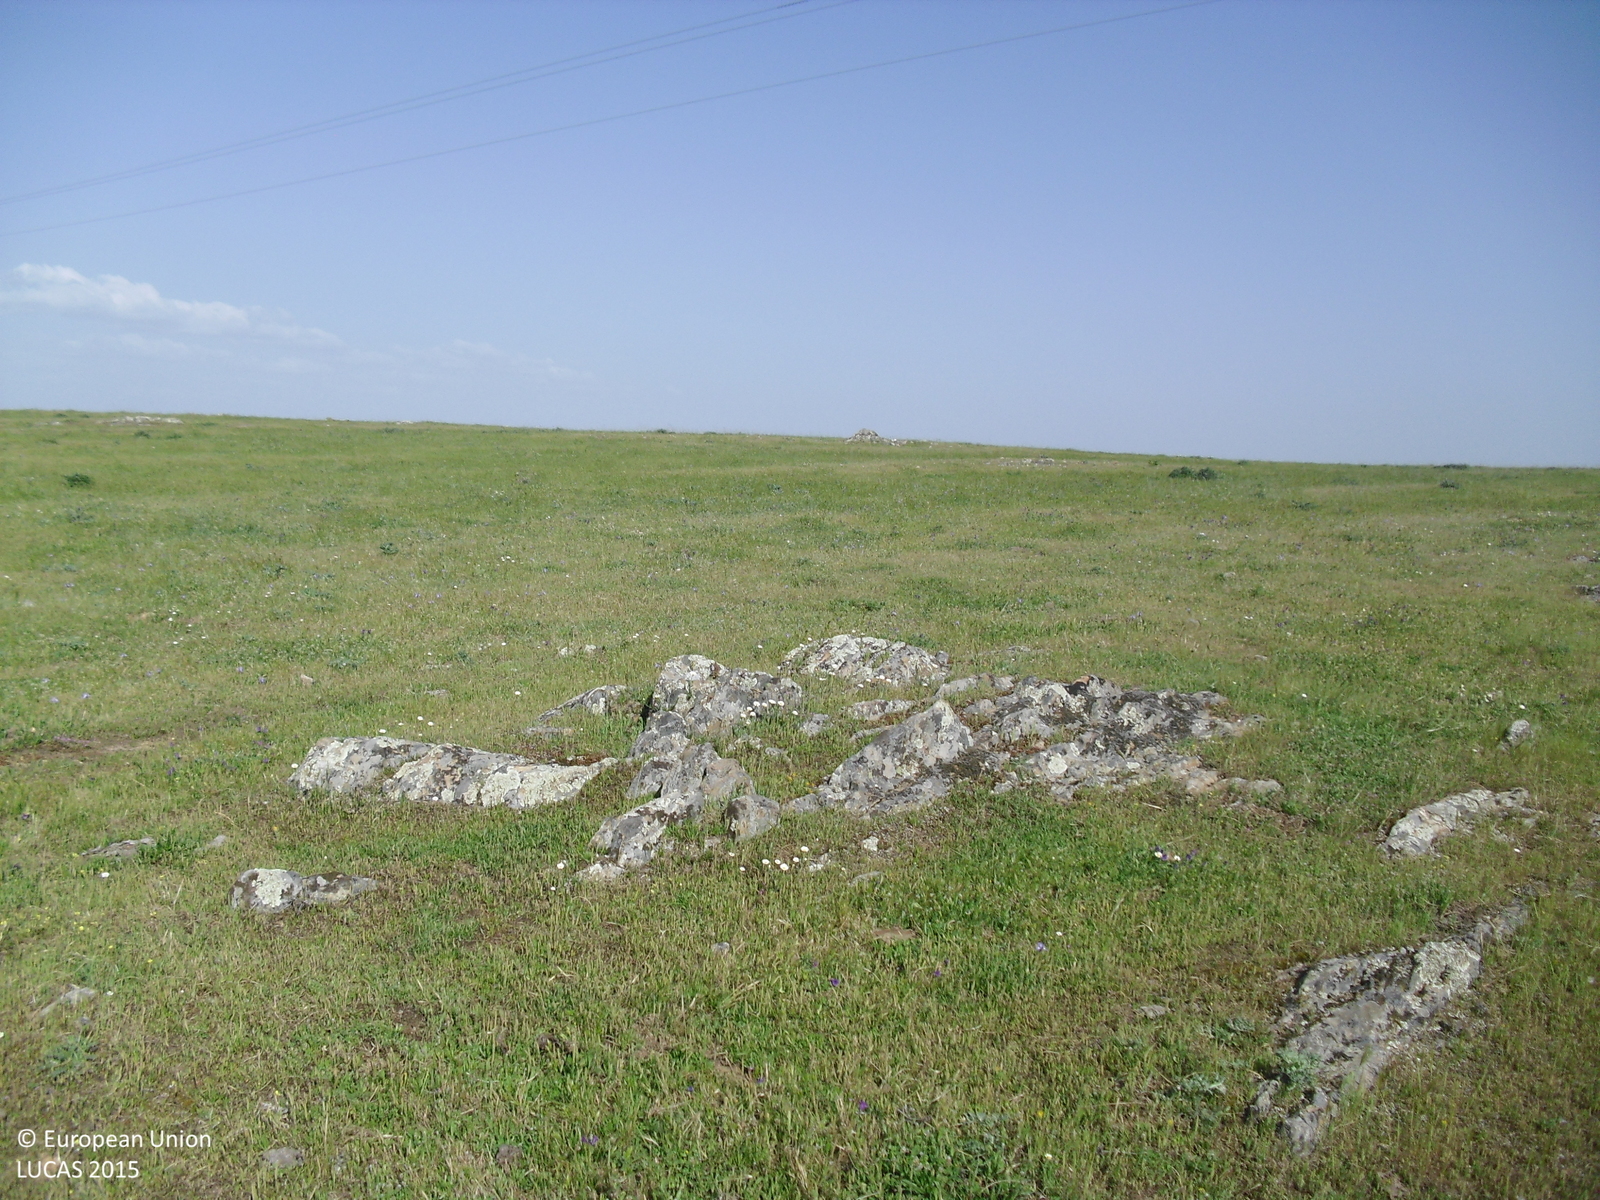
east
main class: Grassland
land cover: Grassland without tree/shrub cover
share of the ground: > 75 %
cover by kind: herbaceous plants 100 %
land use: Agriculture (excluding fallow land and kitchen gardens)
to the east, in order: Grassland without tree/shrub cover; Electric lines; Grassland without tree/shrub cover
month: April
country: ES
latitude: 39.5054
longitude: -6.3854
